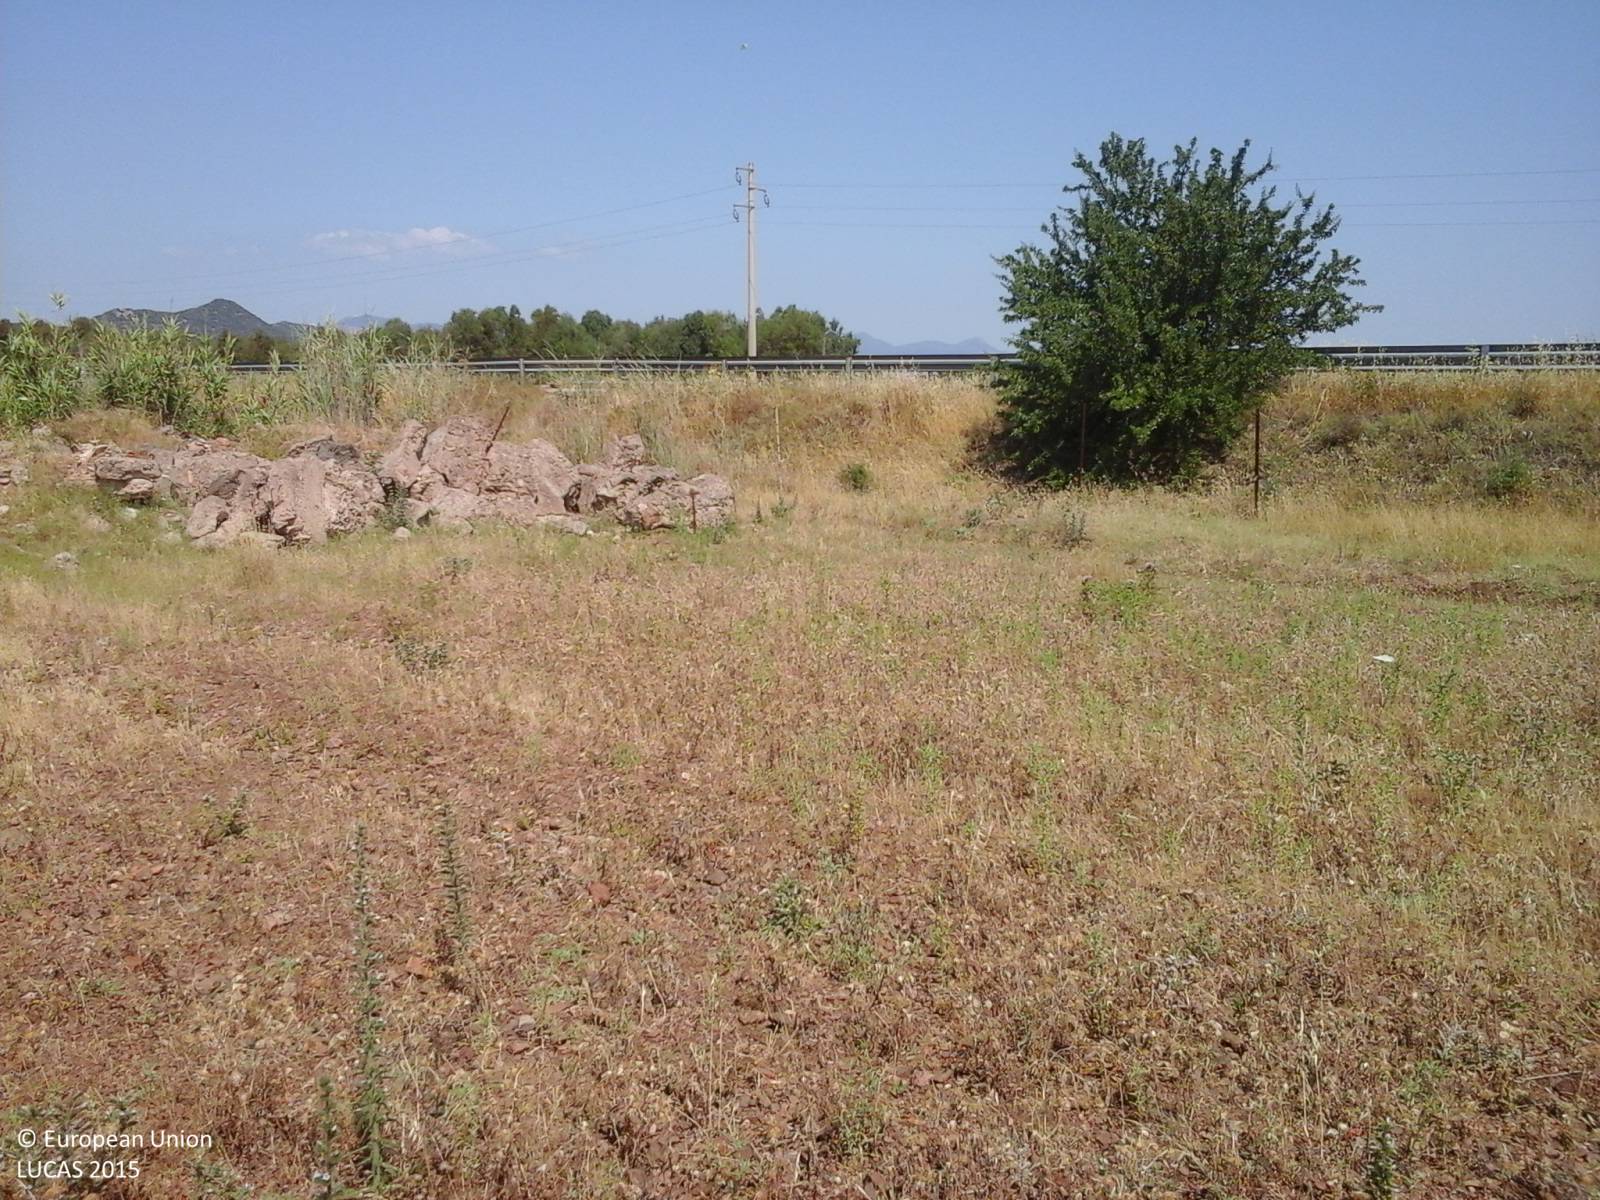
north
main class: Grassland
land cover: Grassland without tree/shrub cover
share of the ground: > 75 %
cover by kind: herbaceous plants 100 %
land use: Agriculture (excluding fallow land and kitchen gardens)
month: June
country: IT
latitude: 39.3012
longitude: 8.9051
